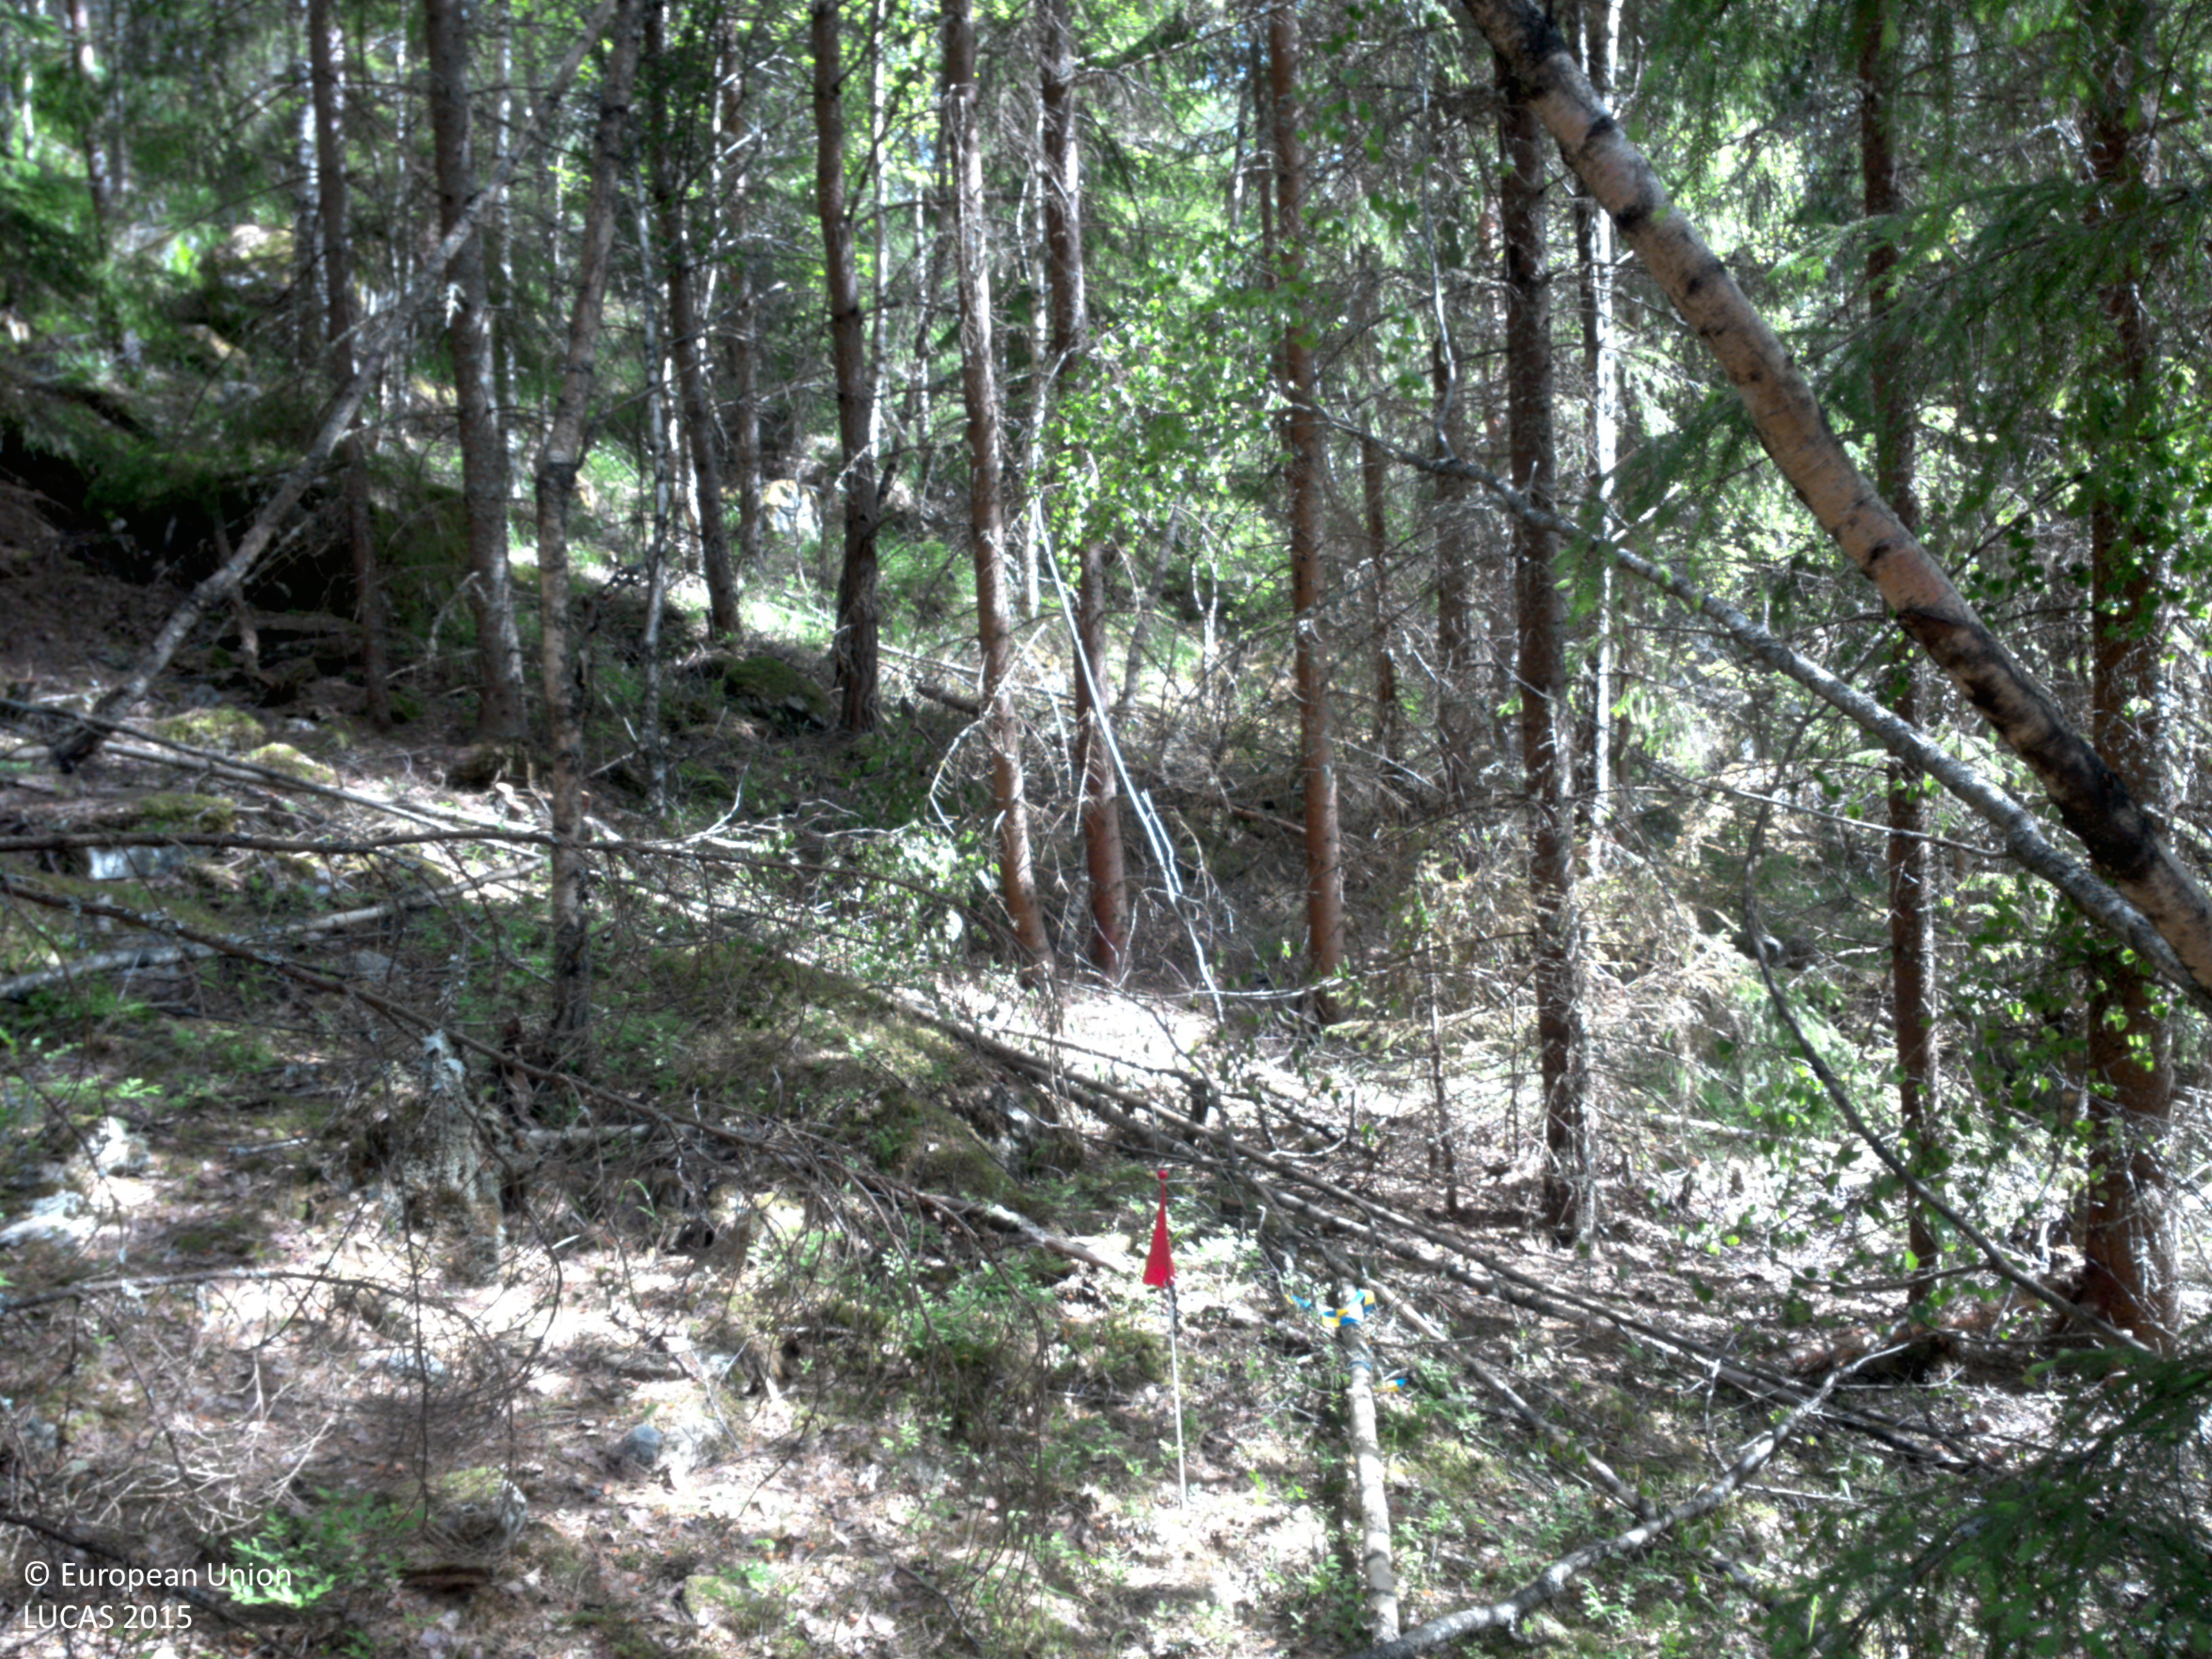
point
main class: Woodland
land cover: Spruce dominated mixed woodland
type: boreal forest
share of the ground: 50 - 75 %
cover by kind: coniferous forest trees 45 %, broadleaved forest trees 25 %, lichens and mosses 20 %, herbaceous plants 10 %
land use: Forestry
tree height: > 5 m
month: June
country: SE
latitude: 59.1539
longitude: 12.2851
